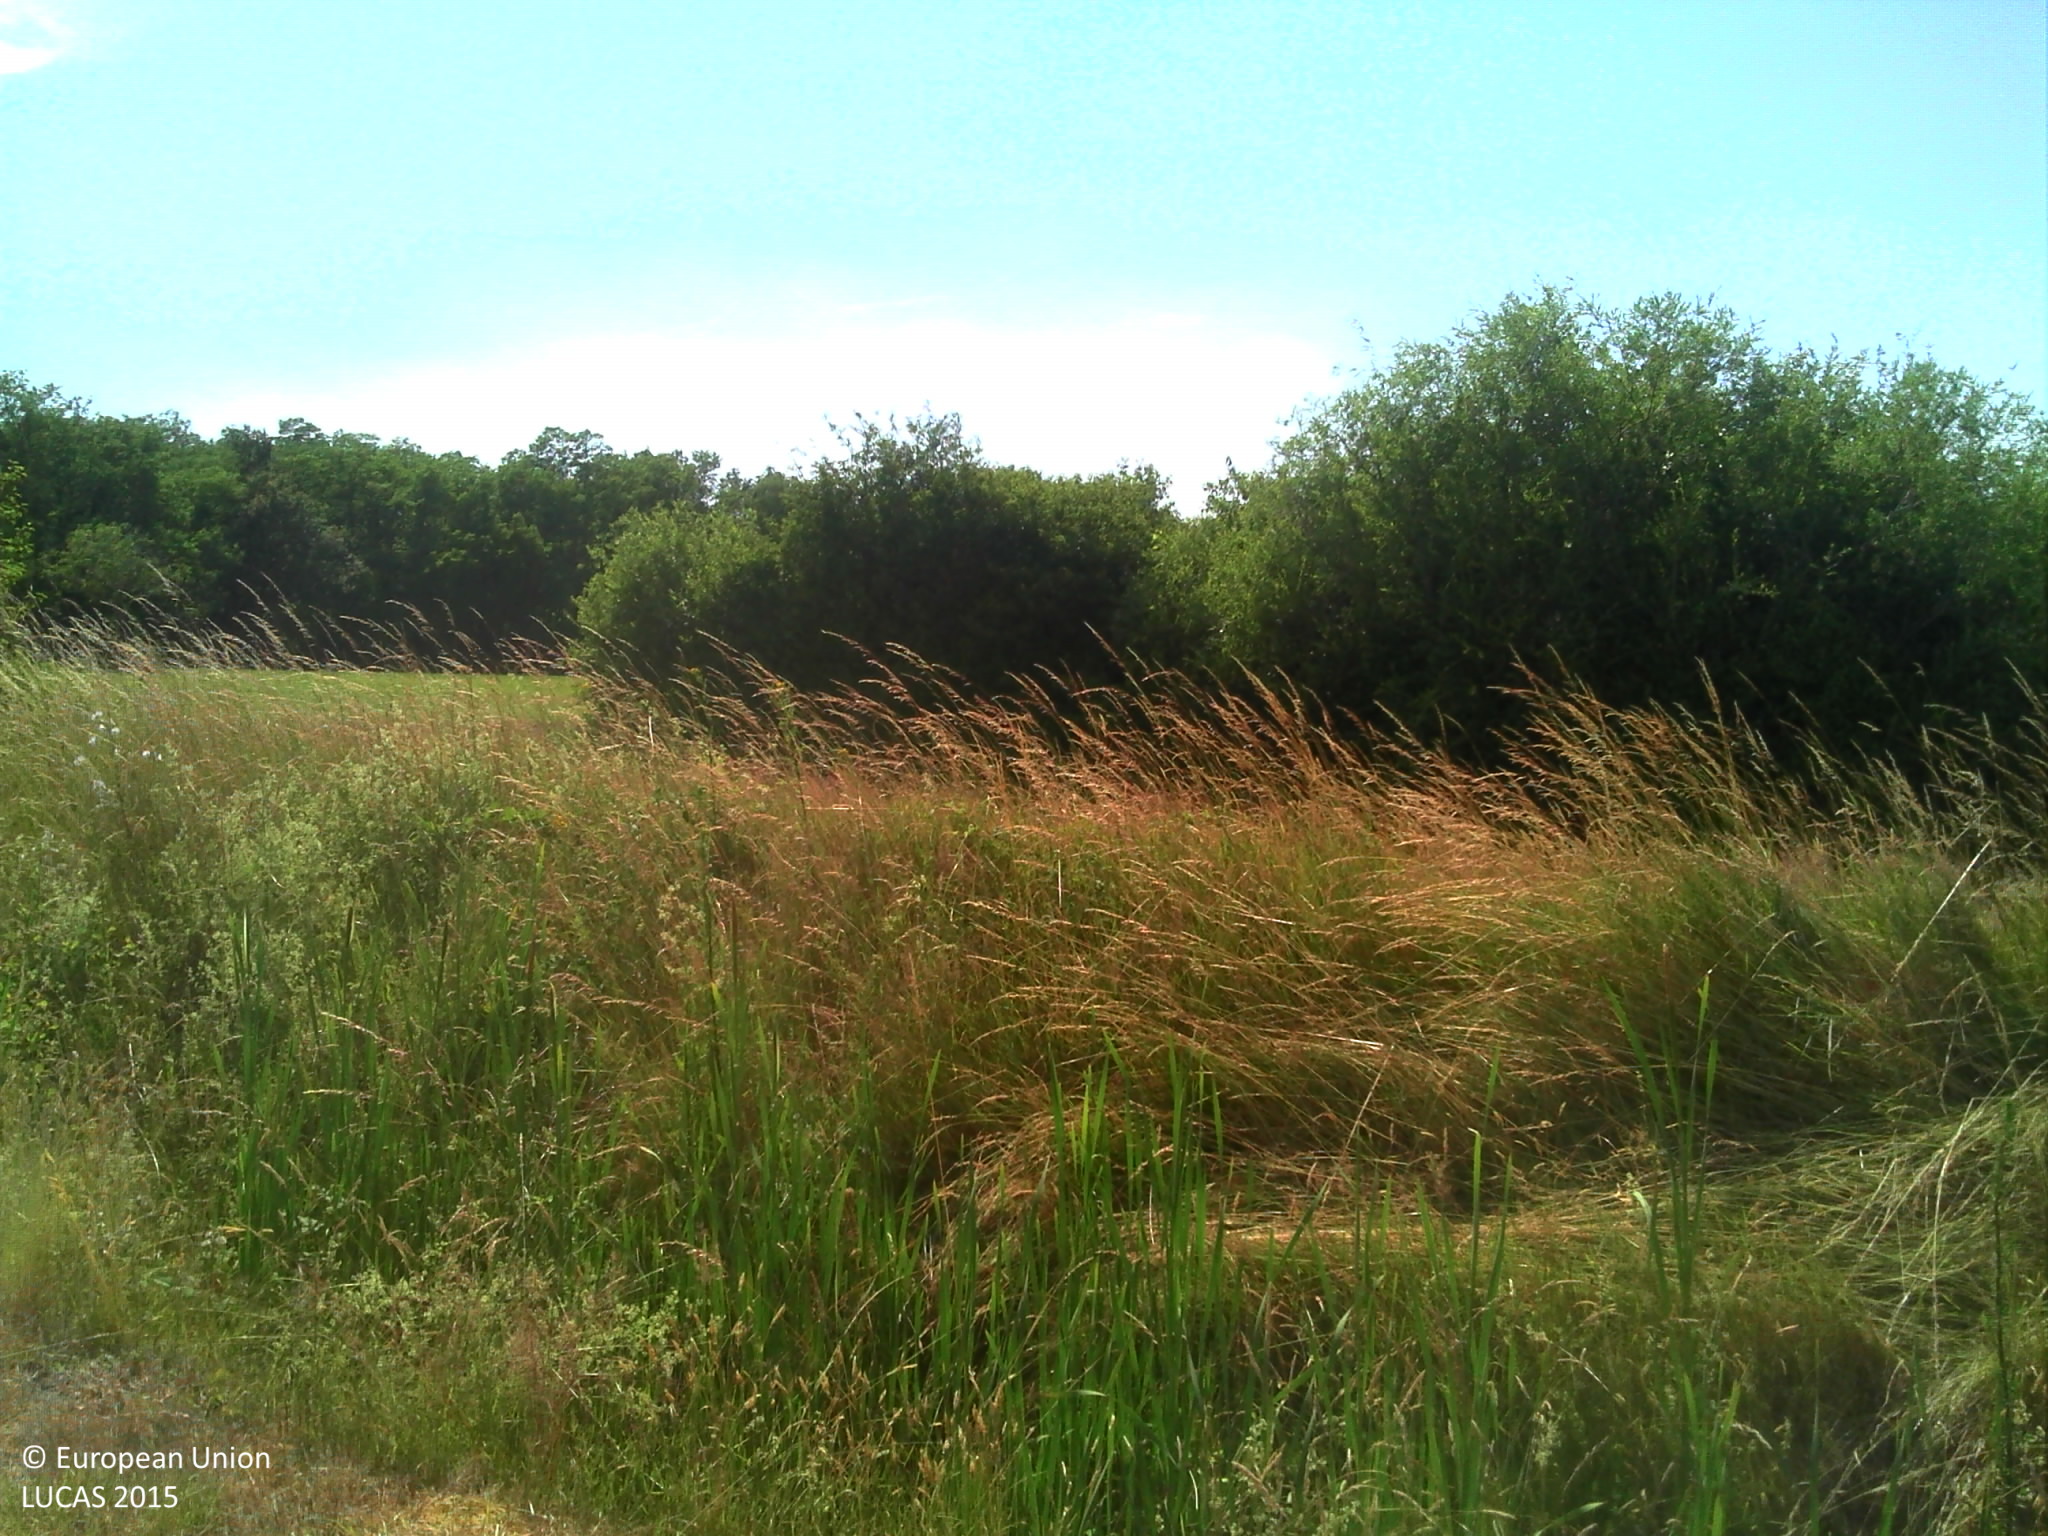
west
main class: Grassland
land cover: Grassland without tree/shrub cover
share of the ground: > 75 %
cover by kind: herbaceous plants 100 %
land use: Air transport
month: June
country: FR
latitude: 47.3629
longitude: 2.9104
